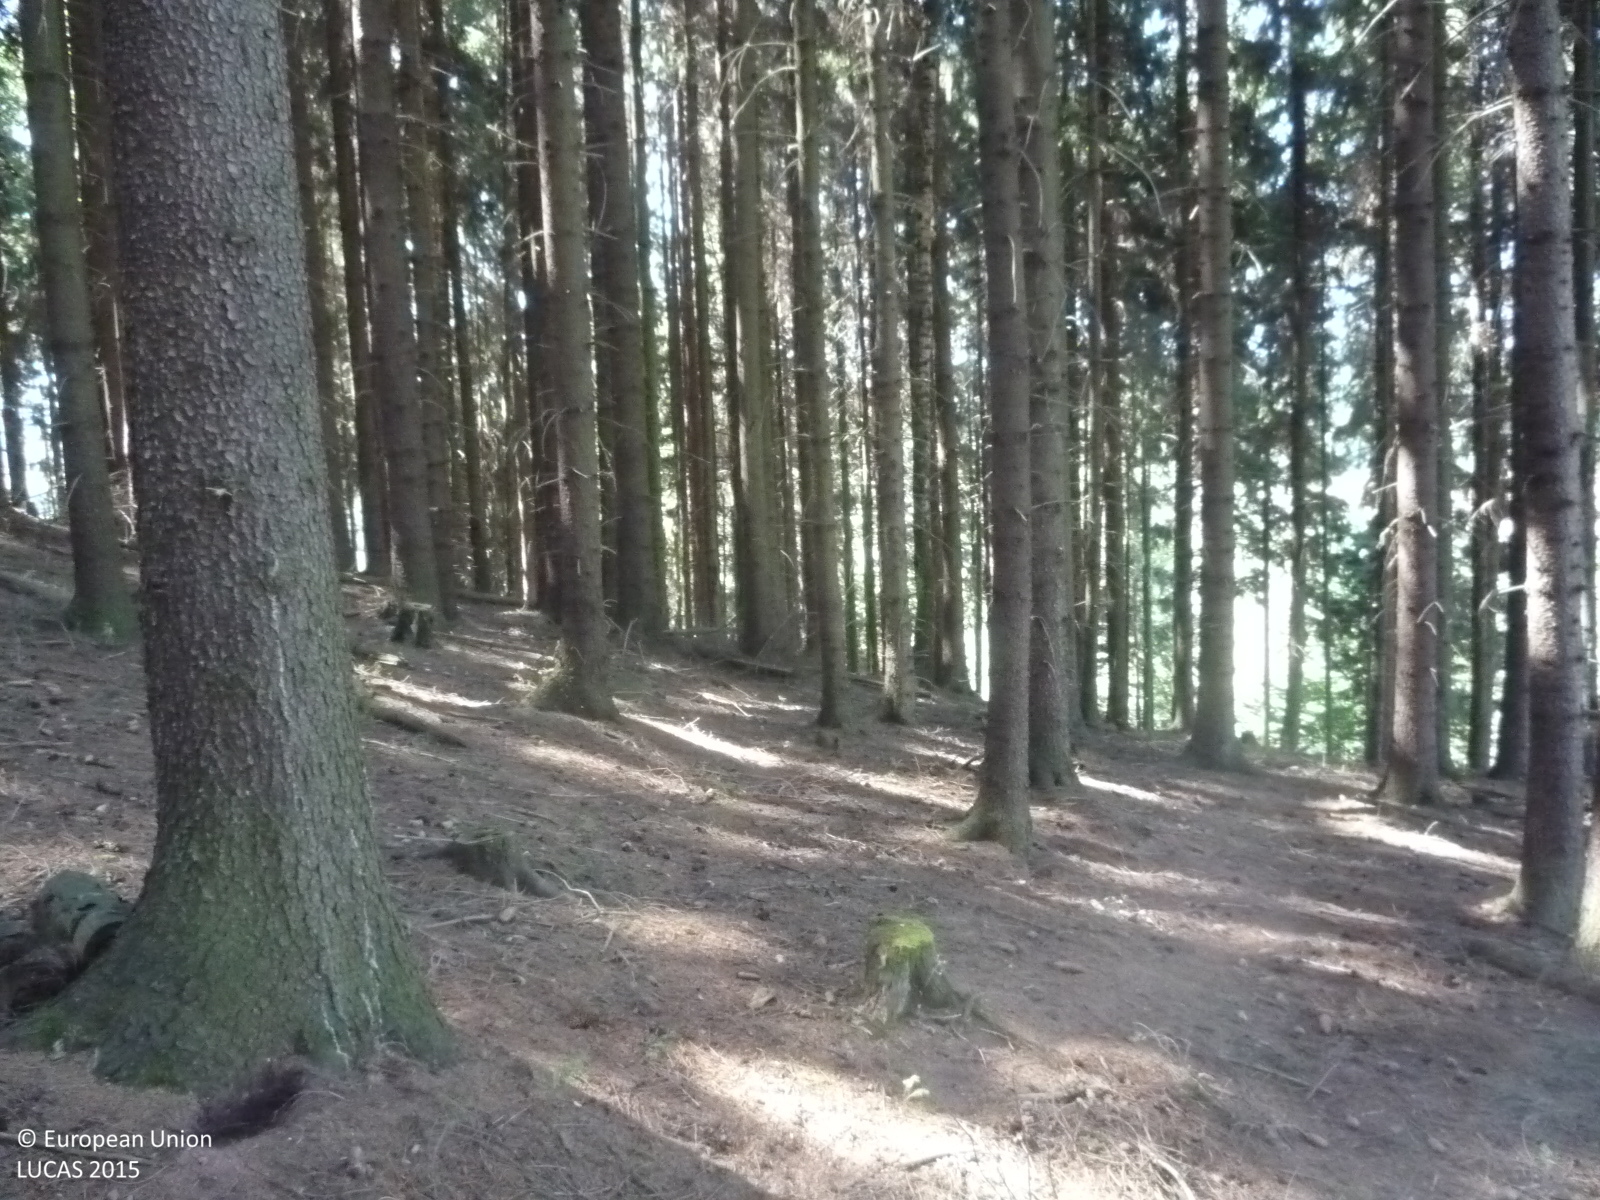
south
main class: Woodland
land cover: Spruce dominated coniferous woodland
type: hemiboreal forest and nemoral coniferous forest and mixed broadleaved-coniferous forest
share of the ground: > 75 %
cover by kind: coniferous forest trees 95 %, unconsolidated bare surface 5 %
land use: Forestry
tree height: > 5 m
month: July
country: CZ
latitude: 50.5275
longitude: 15.7180
